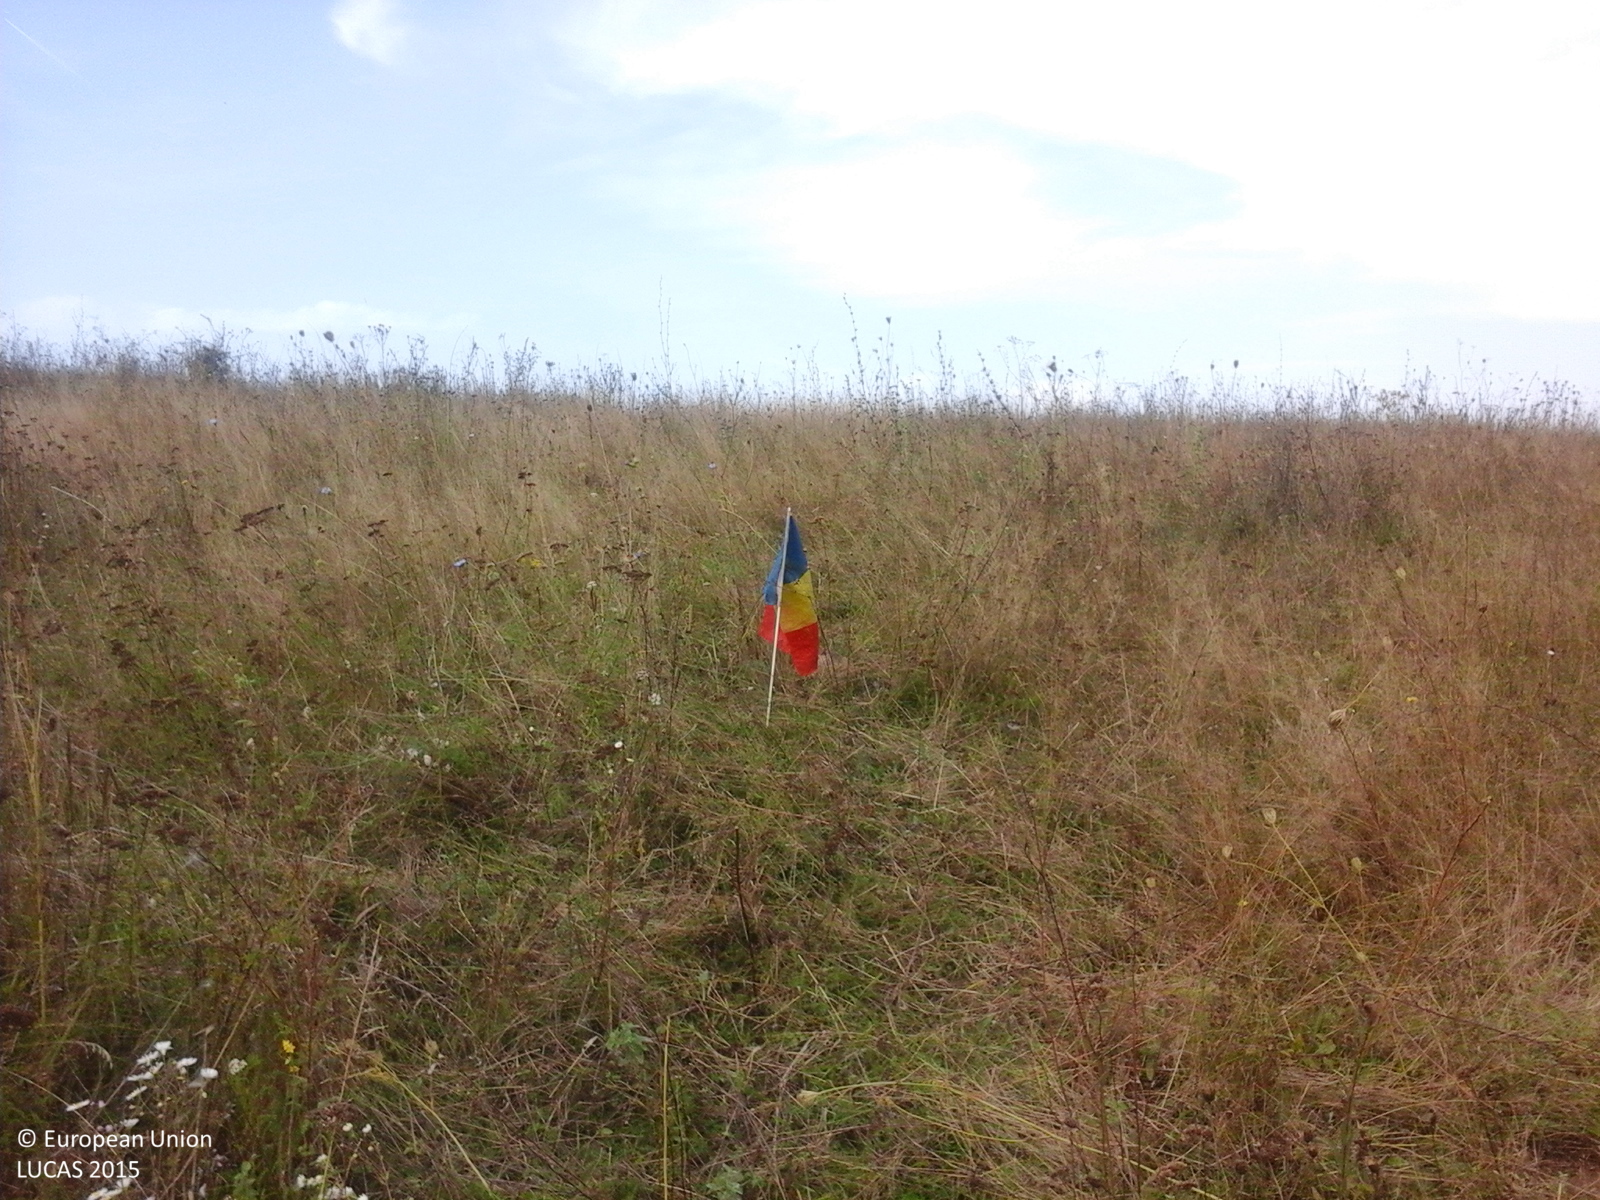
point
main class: Grassland
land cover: Grassland without tree/shrub cover
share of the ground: > 75 %
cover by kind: herbaceous plants 100 %
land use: Agriculture (excluding fallow land and kitchen gardens)
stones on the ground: < 10 %
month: September
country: RO
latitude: 46.9539
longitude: 23.0315
